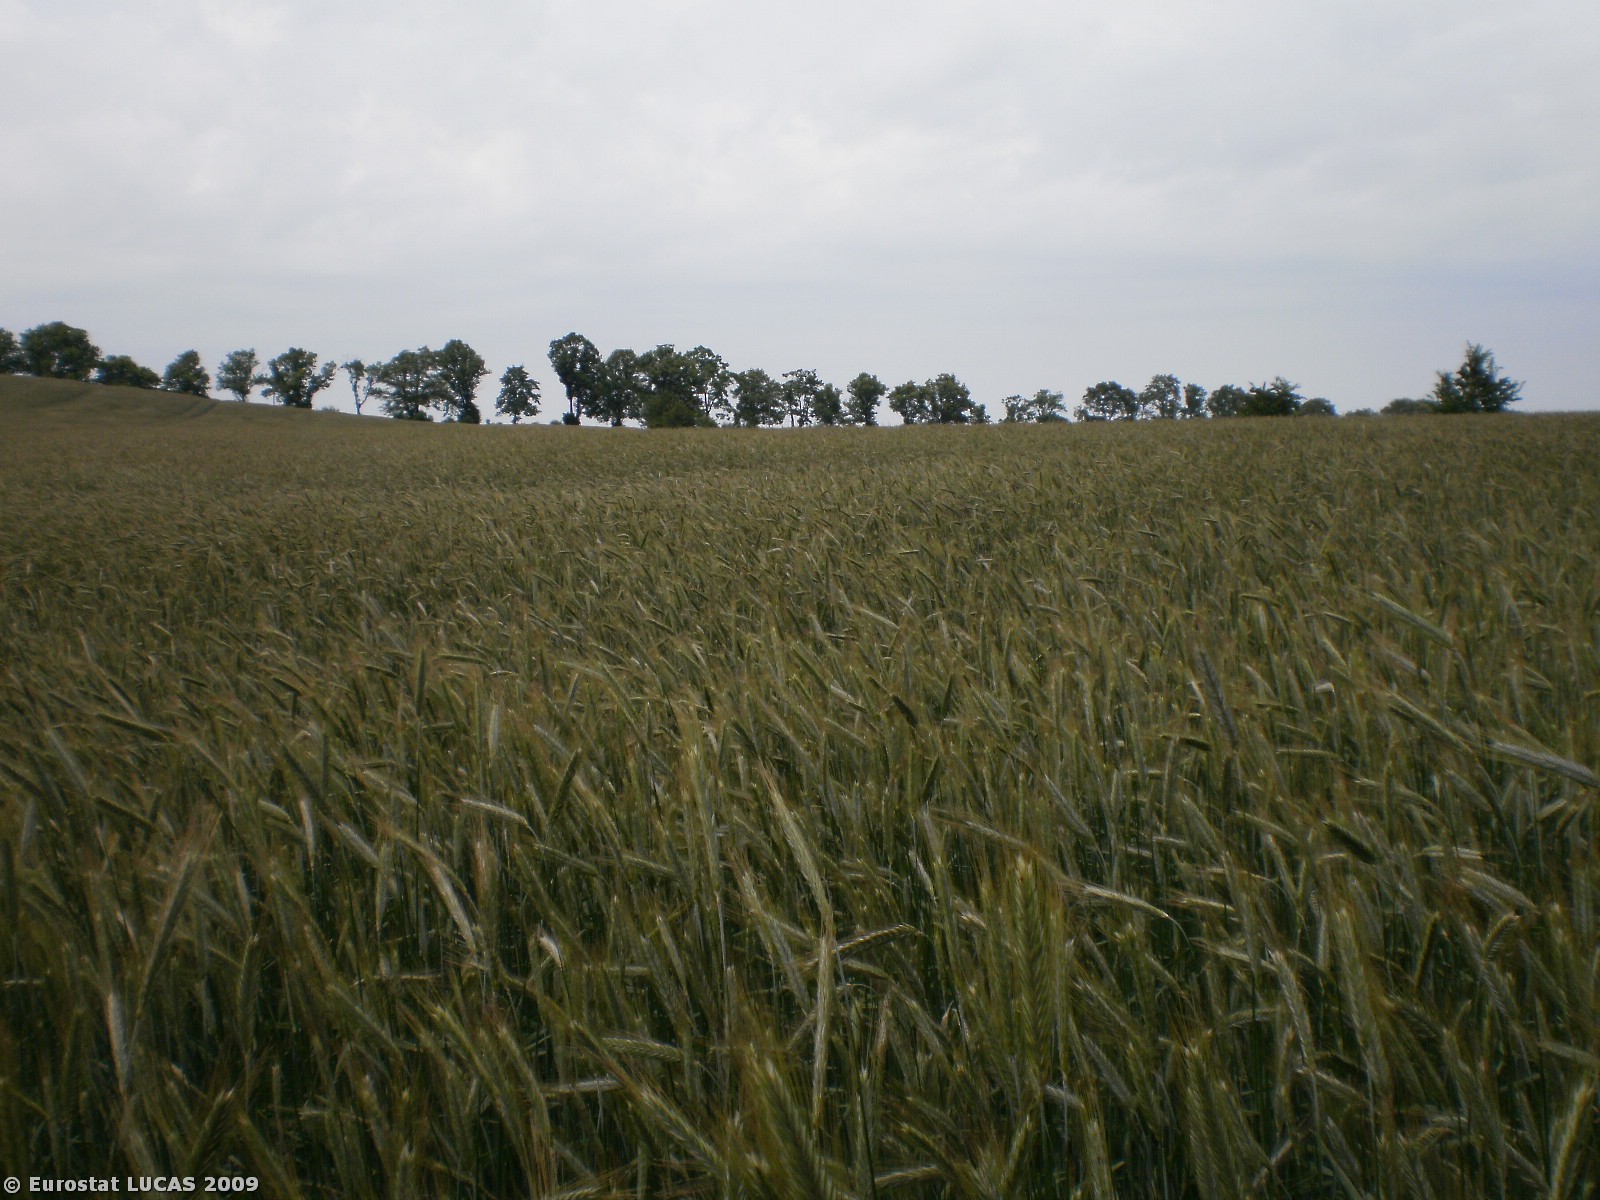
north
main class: Cropland
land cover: Rye
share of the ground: > 75 %
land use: Agriculture (excluding fallow land and kitchen gardens)
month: June
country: PL
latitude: 54.7502
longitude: 17.9206
